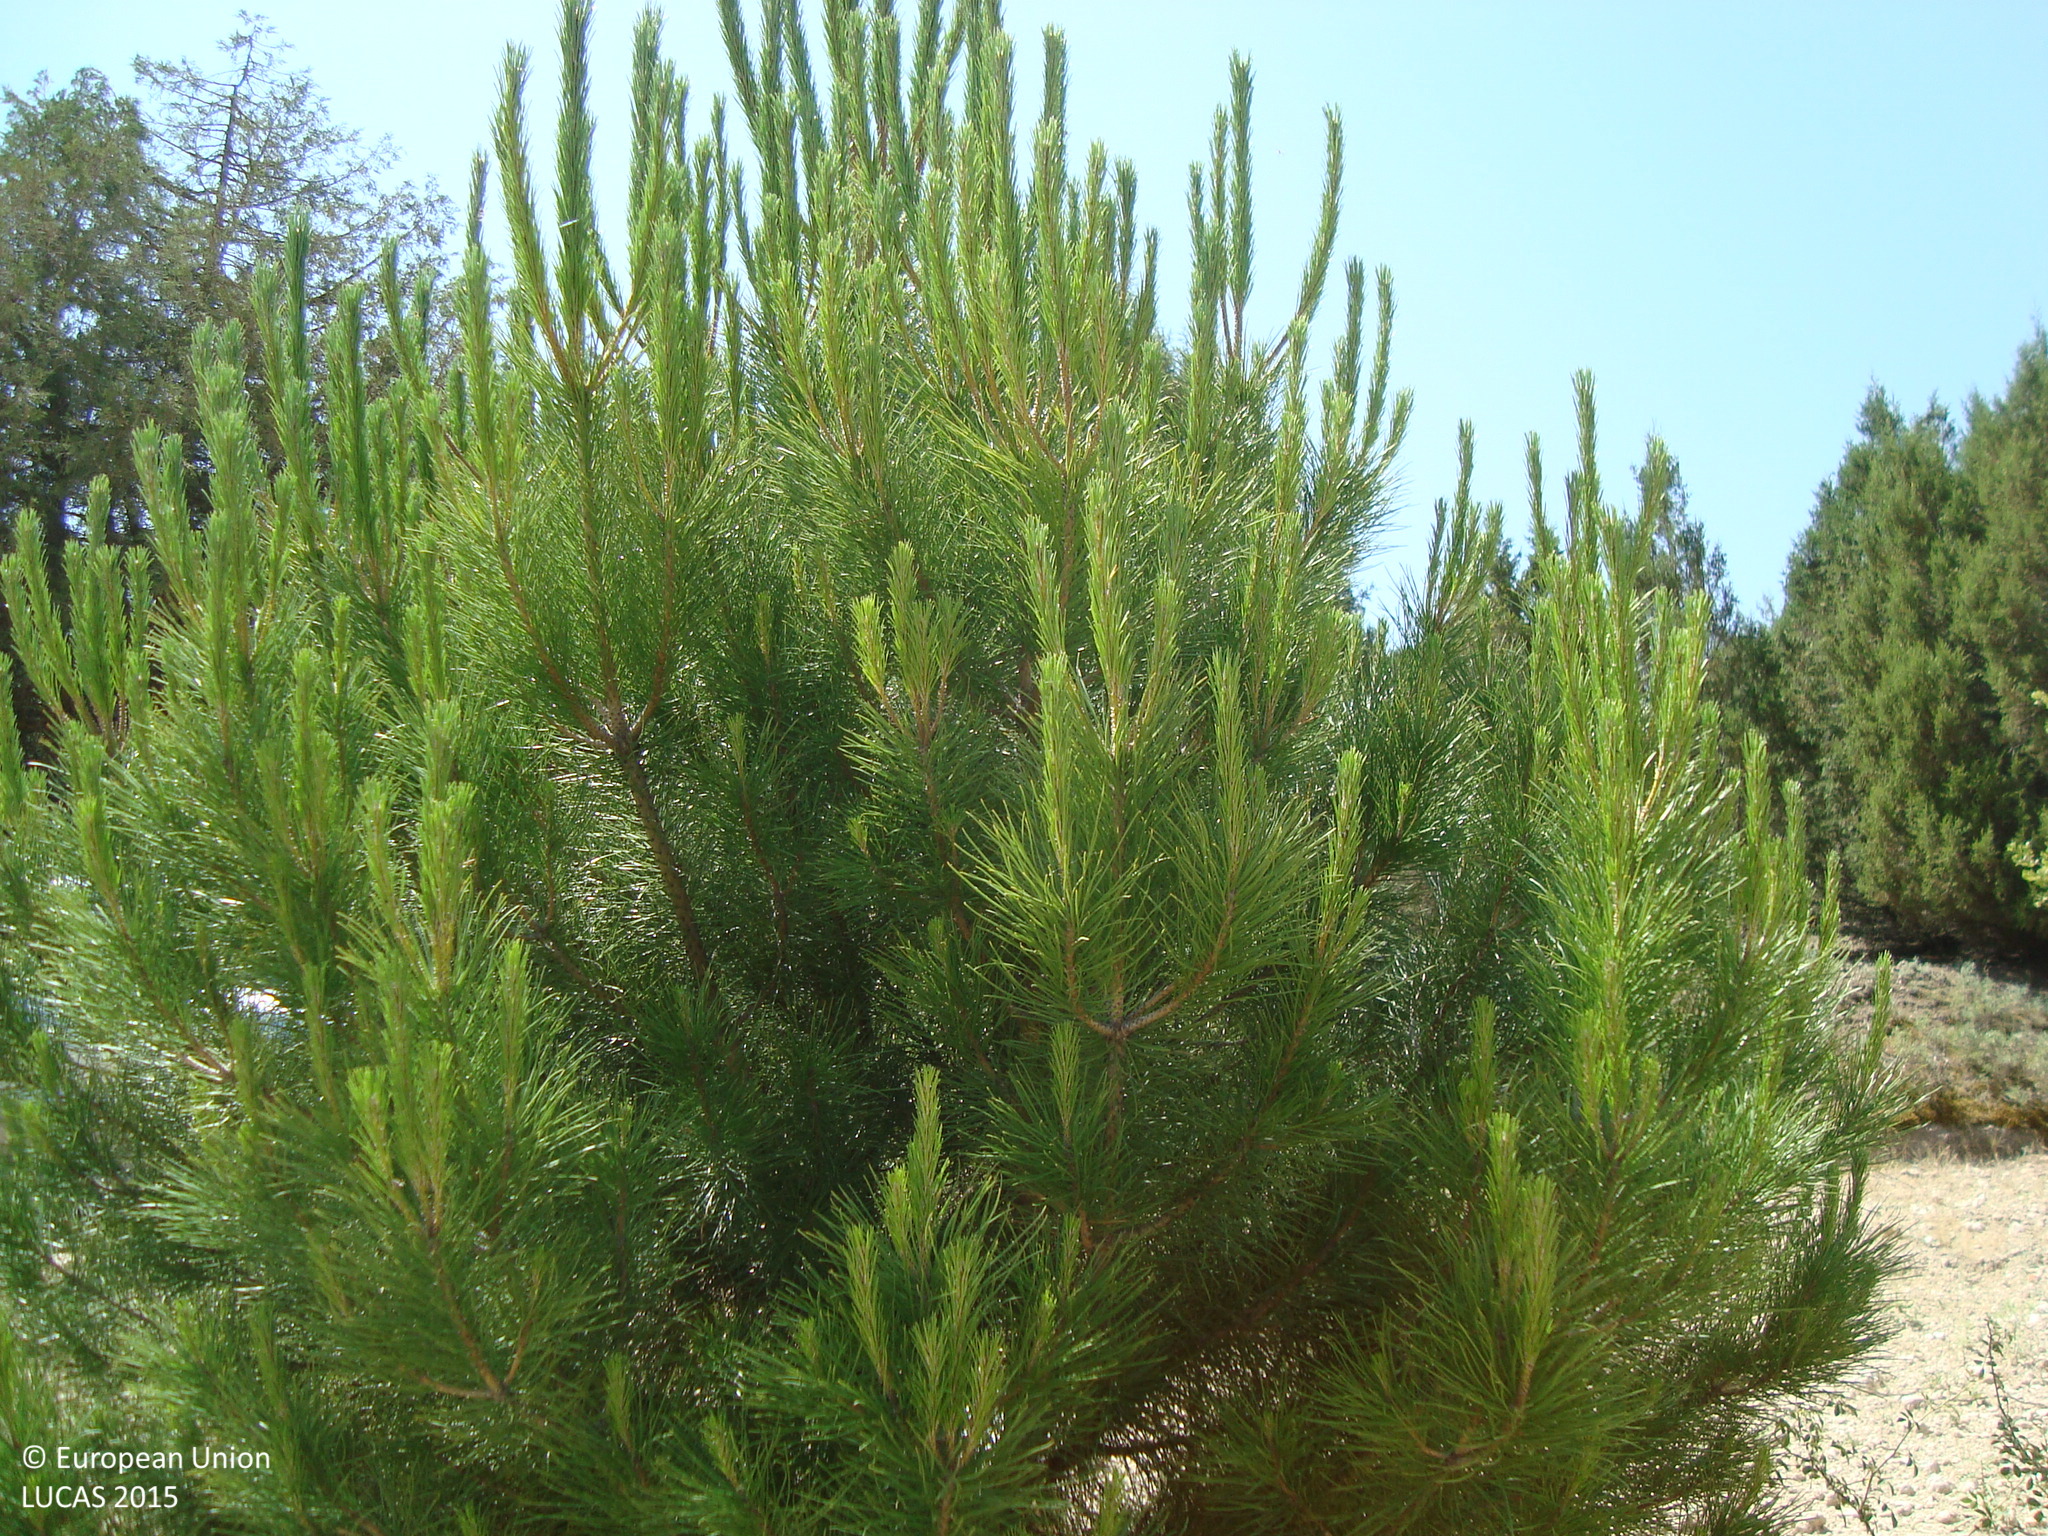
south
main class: Woodland
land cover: Pine dominated coniferous woodland
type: coniferous forest of the mediterranean region
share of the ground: 50 - 75 %
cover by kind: coniferous forest trees 45 %, unconsolidated bare surface 30 %, broadleaved forest trees 10 %, herbaceous plants 10 %, shrubs 5 %
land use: Forestry
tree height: < 5 m
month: July
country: ES
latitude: 41.8475
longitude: -3.8232
